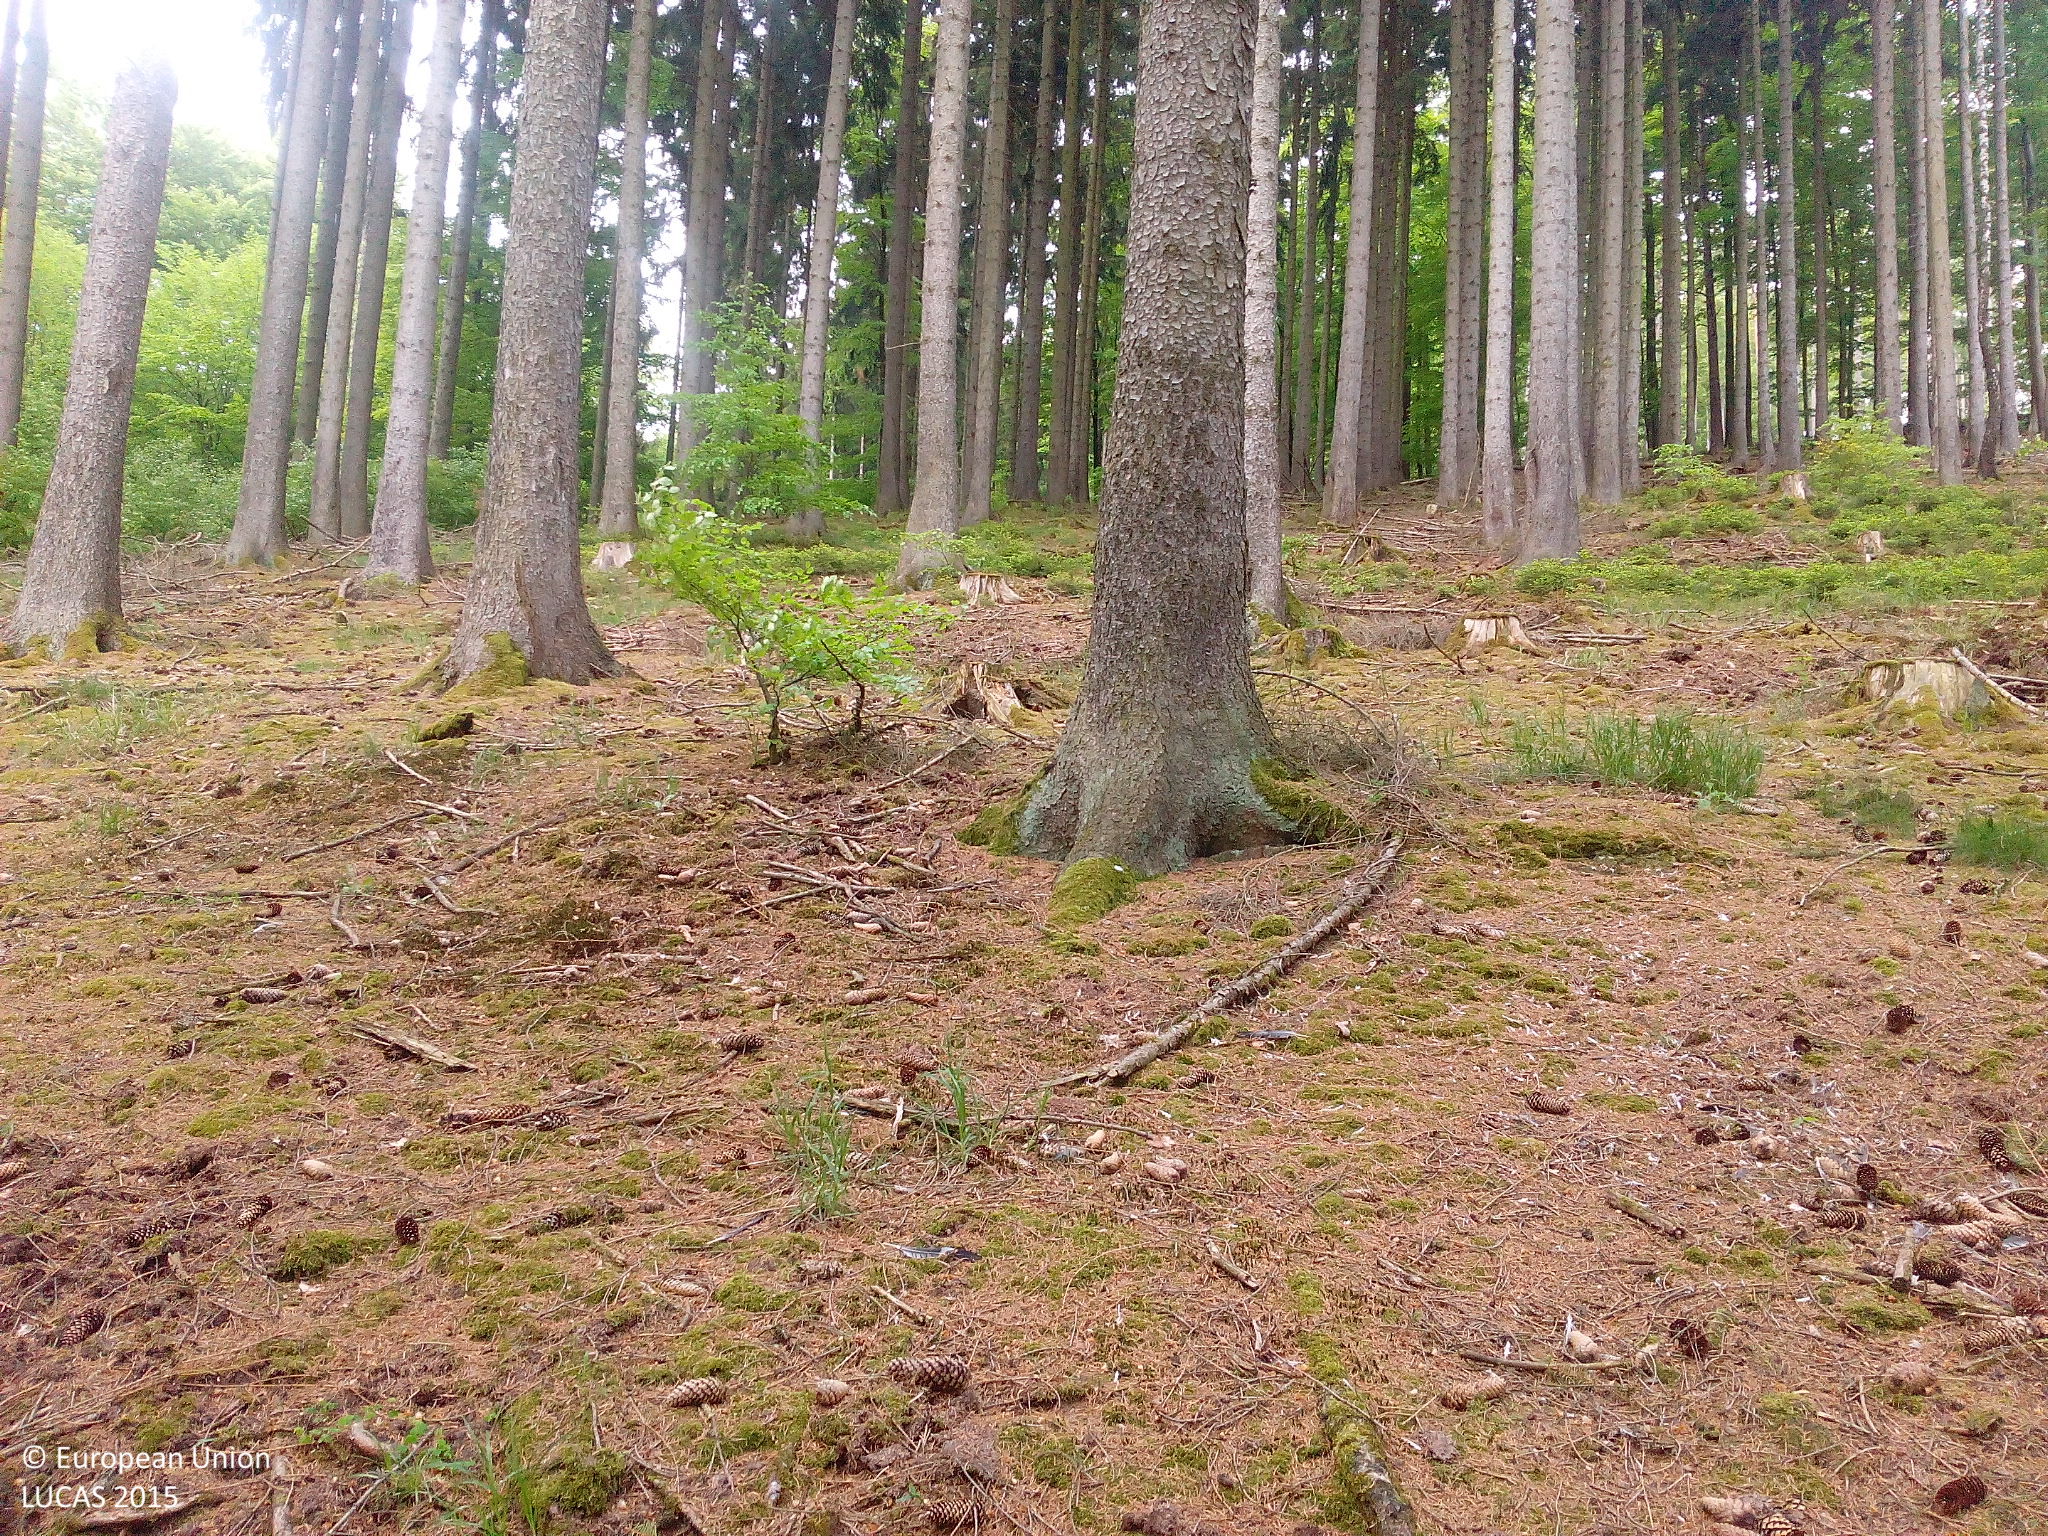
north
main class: Woodland
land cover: Spruce dominated coniferous woodland
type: hemiboreal forest and nemoral coniferous forest and mixed broadleaved-coniferous forest
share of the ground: > 75 %
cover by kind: coniferous forest trees 60 %, unconsolidated bare surface 35 %, lichens and mosses 5 %
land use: Forestry
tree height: > 5 m
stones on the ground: < 10 %
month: May
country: DE
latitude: 51.1910
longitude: 9.8713
